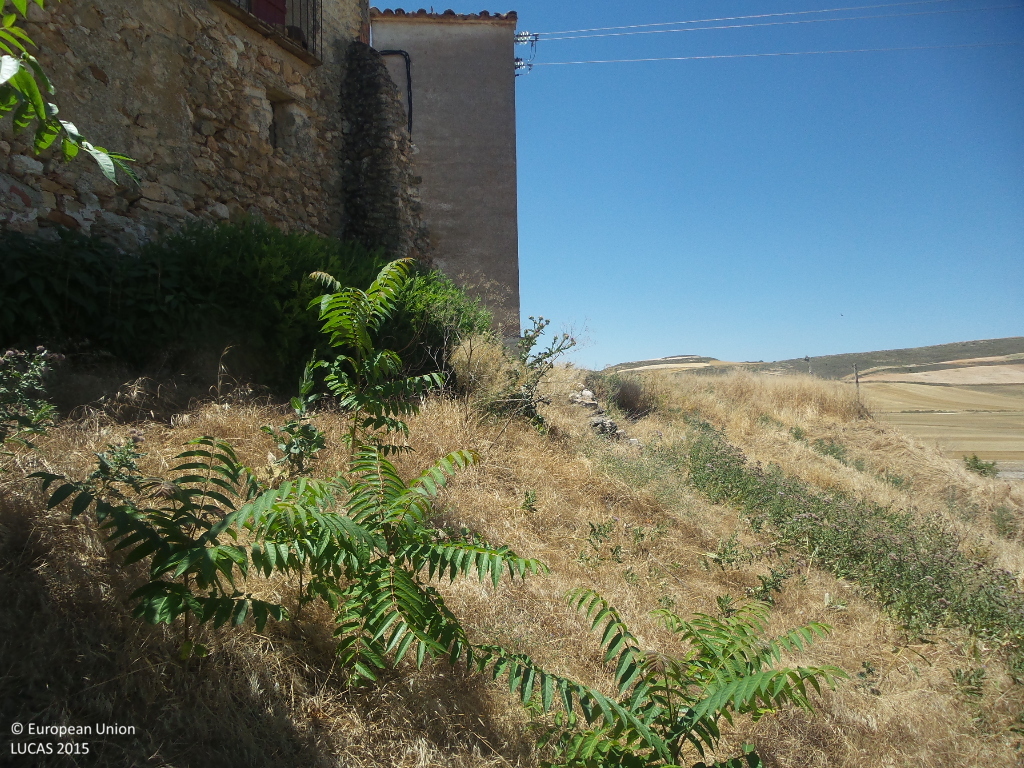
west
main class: Grassland
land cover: Grassland with sparse tree/shrub cover
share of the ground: > 75 %
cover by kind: herbaceous plants 95 %, broadleaved forest trees 5 %
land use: Semi-natural and natural areas not in use
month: July
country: ES
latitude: 41.4175
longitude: -2.0782
